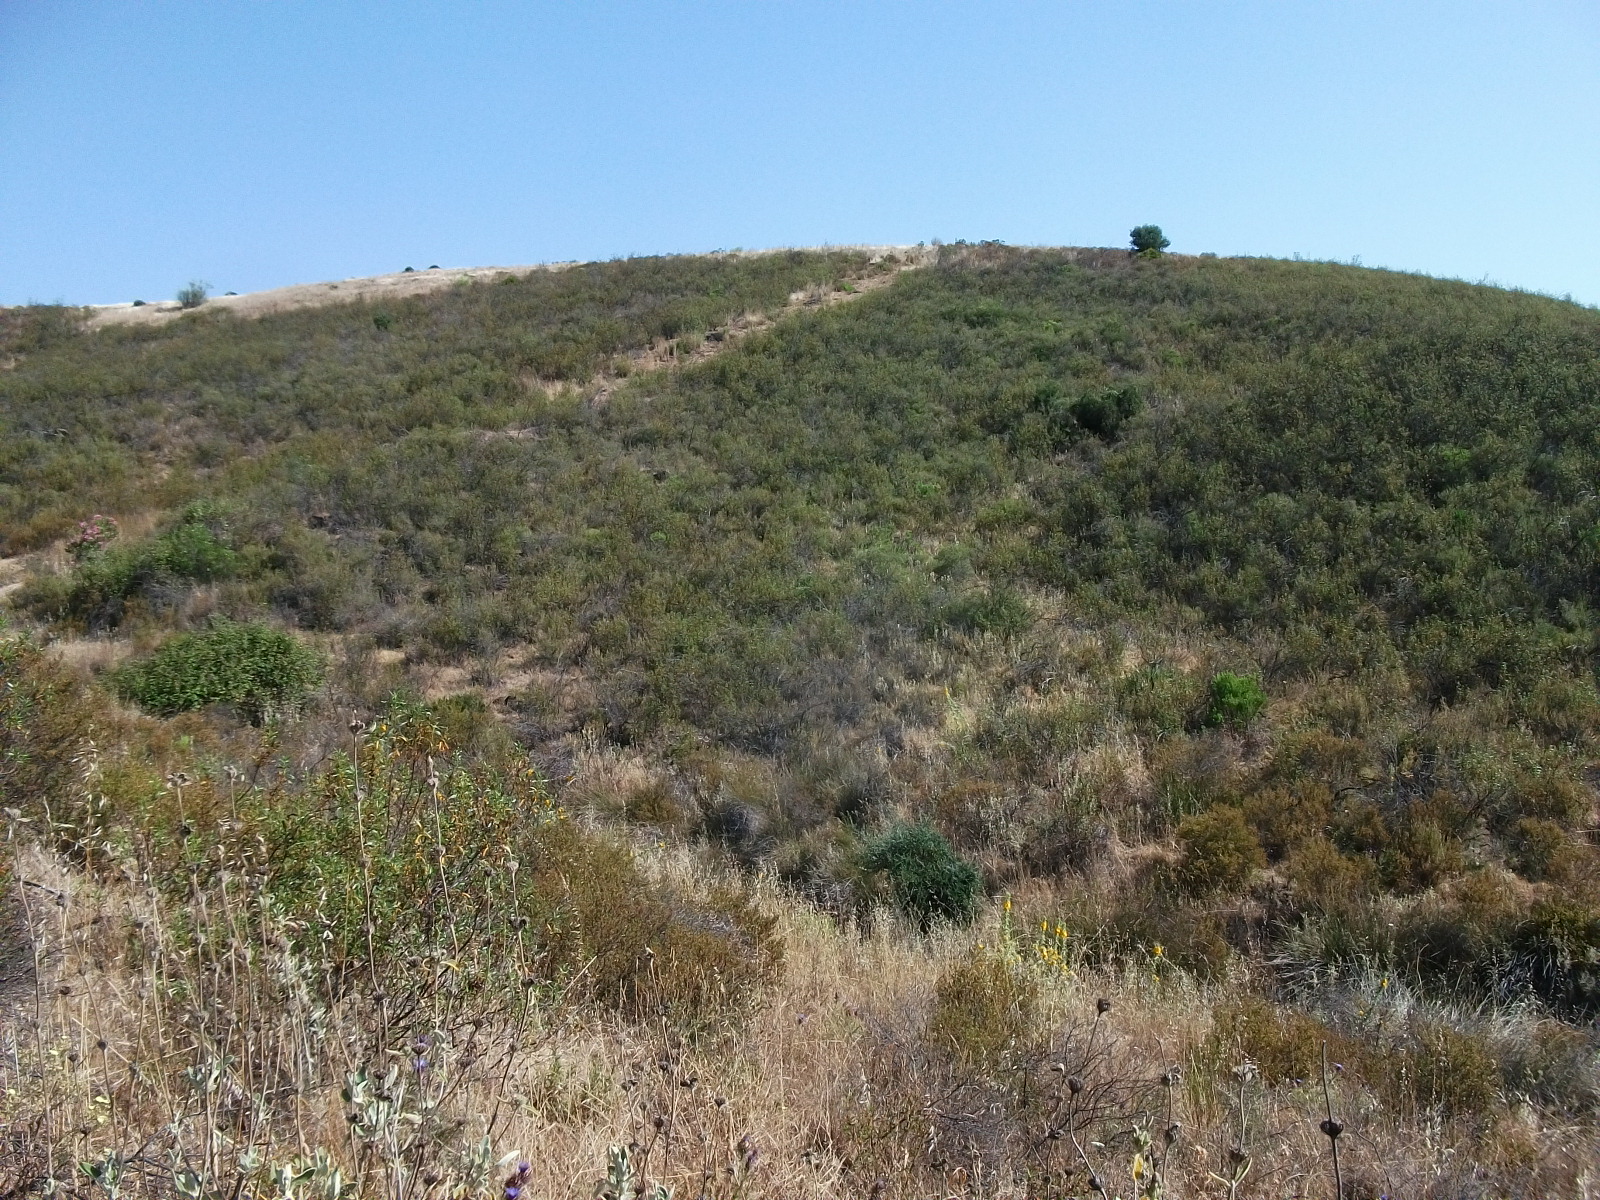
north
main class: Shrubland
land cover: Shrubland without tree cover
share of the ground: > 75 %
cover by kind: shrubs 95 %, herbaceous plants 5 %
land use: Agriculture (excluding fallow land and kitchen gardens)
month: June
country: ES
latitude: 37.4377
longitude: -6.6158
